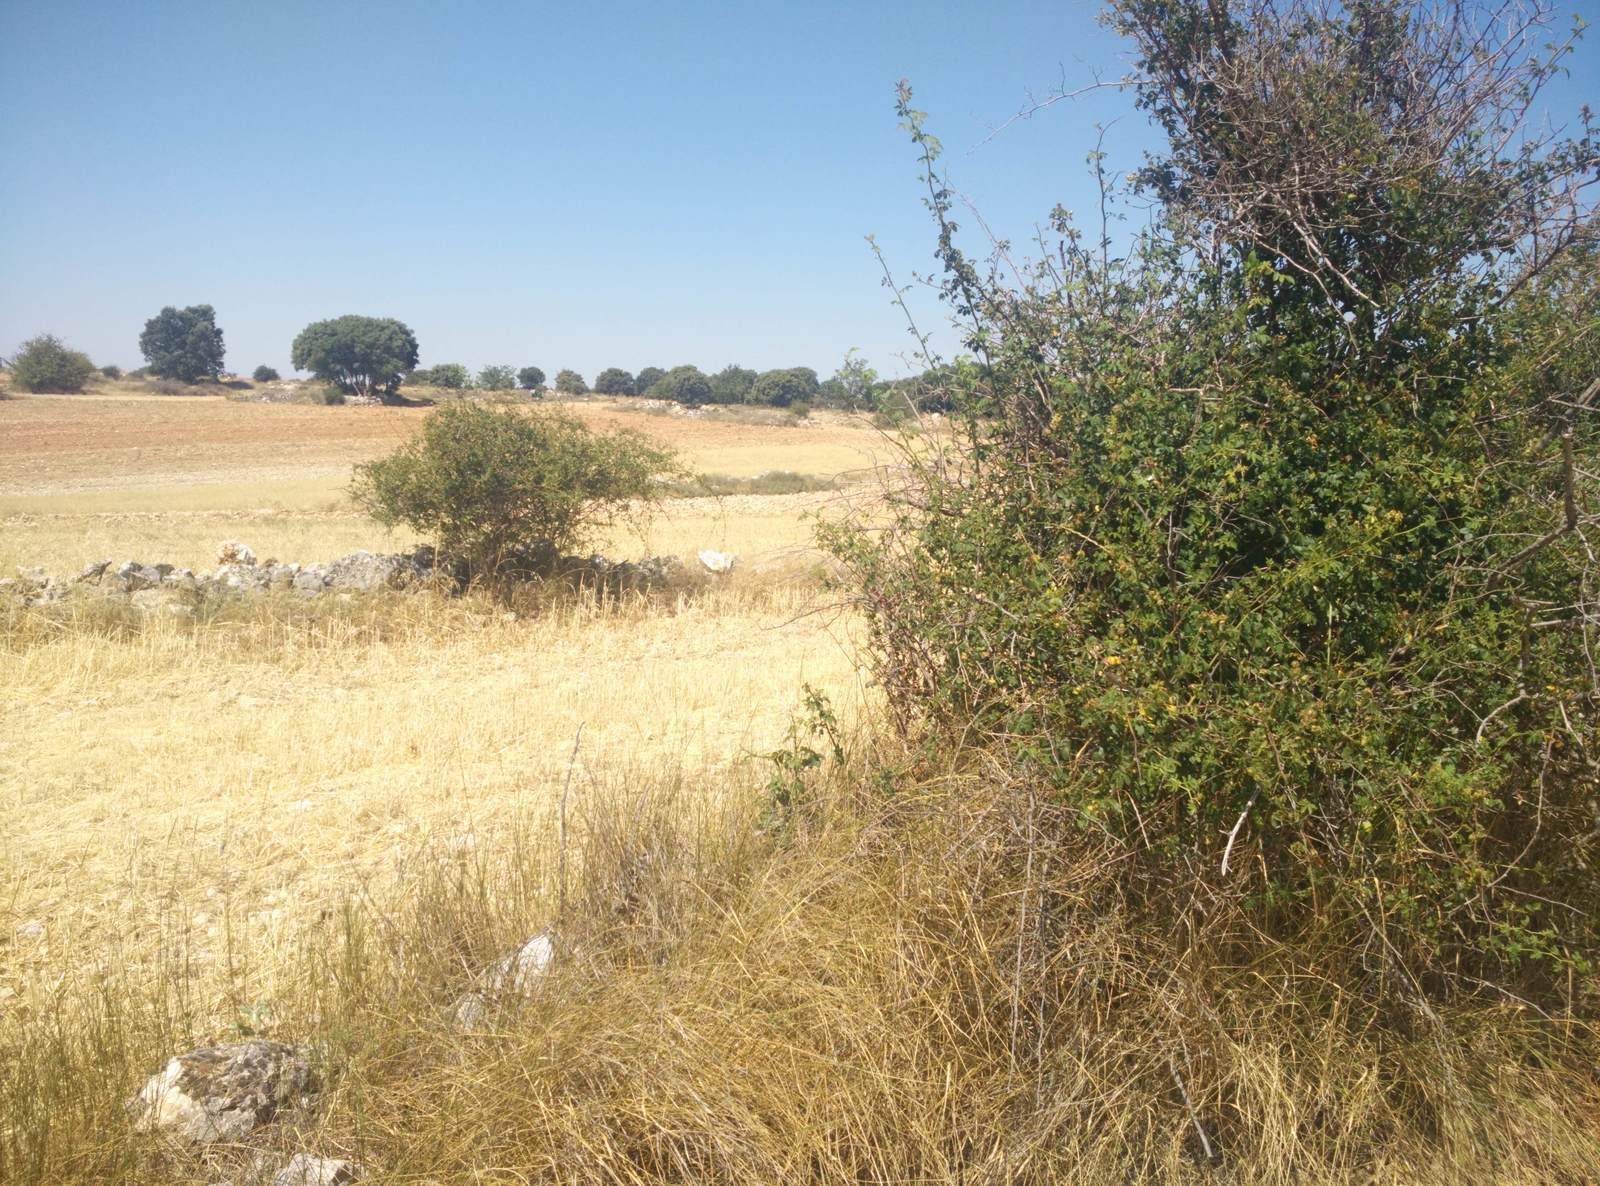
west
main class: Cropland
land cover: Barley
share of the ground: < 10 %
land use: Agriculture (excluding fallow land and kitchen gardens)
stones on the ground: > 50 %
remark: Harvested field
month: July
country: ES
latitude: 40.9127
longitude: -2.8917
